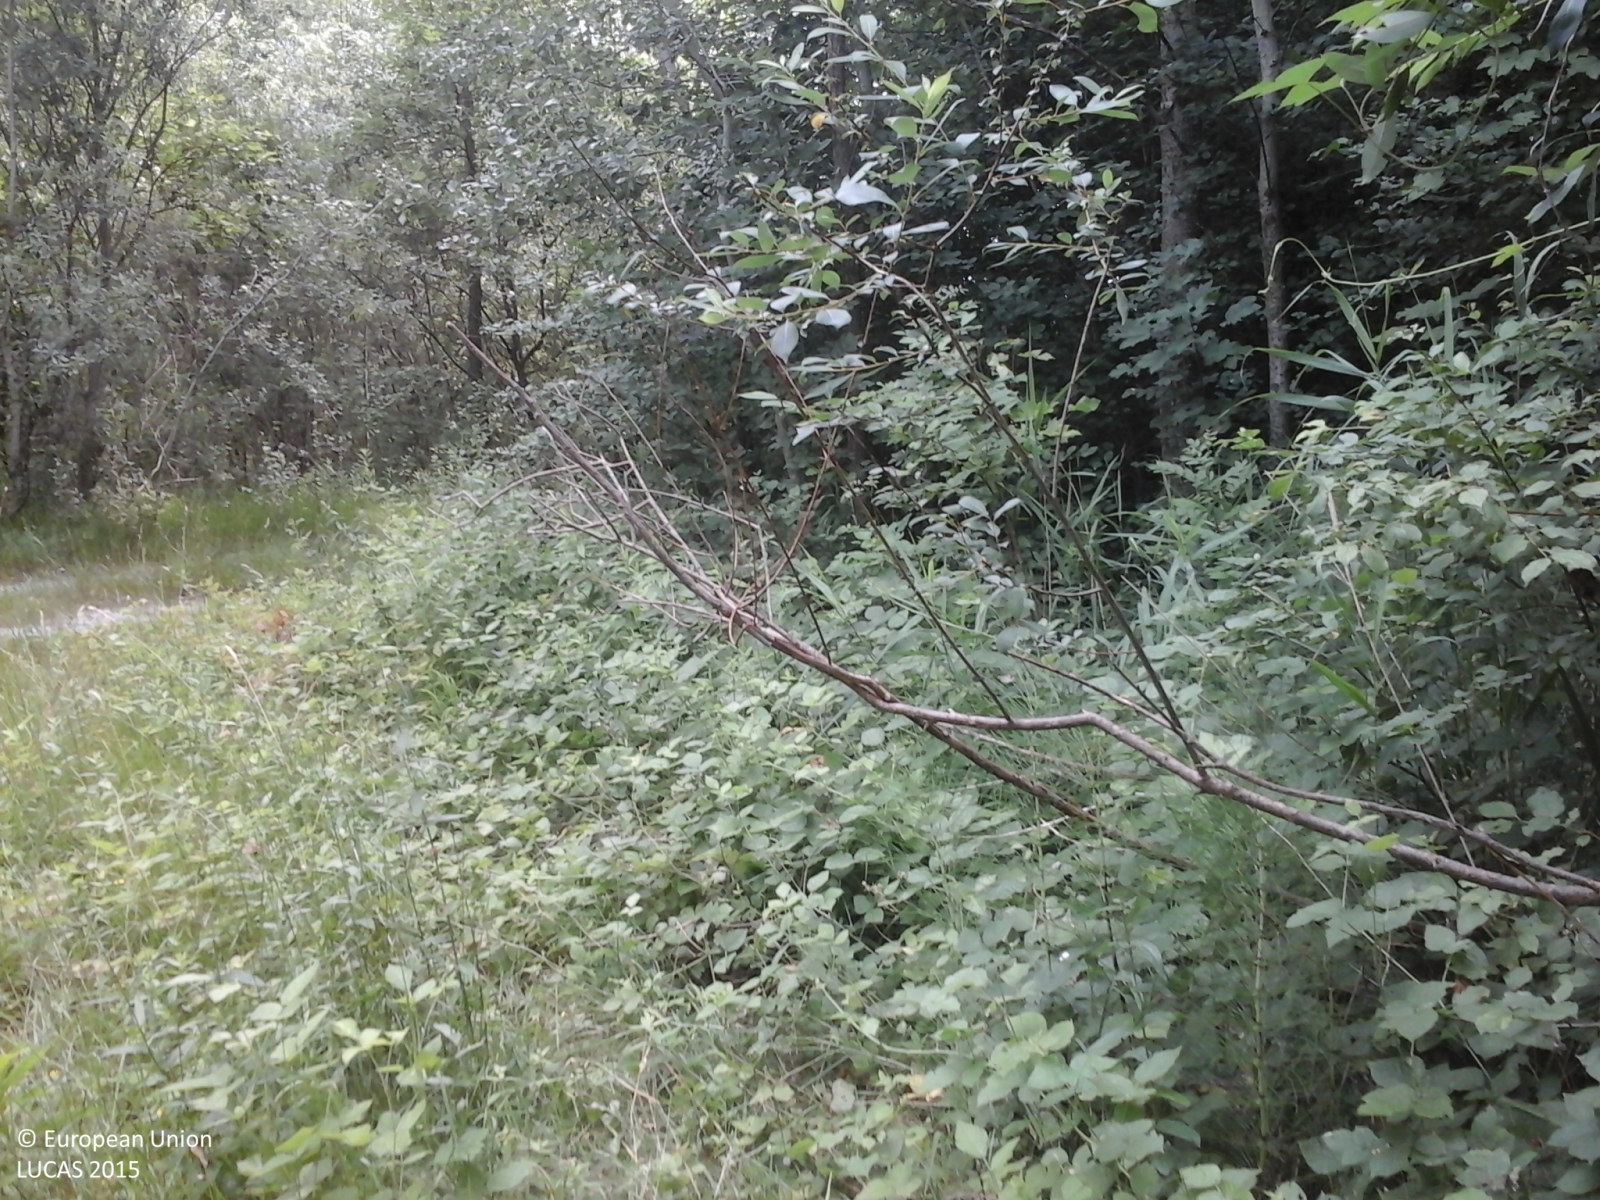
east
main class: Woodland
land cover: Broadleaved woodland
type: thermophilous deciduous forest
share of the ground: > 75 %
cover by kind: broadleaved forest trees 100 %
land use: Semi-natural and natural areas not in use
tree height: > 5 m
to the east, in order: Broadleaved woodland; Ditches and canals; Grassland without tree/shrub cover
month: July
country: IT
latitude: 45.1245
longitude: 7.1949
